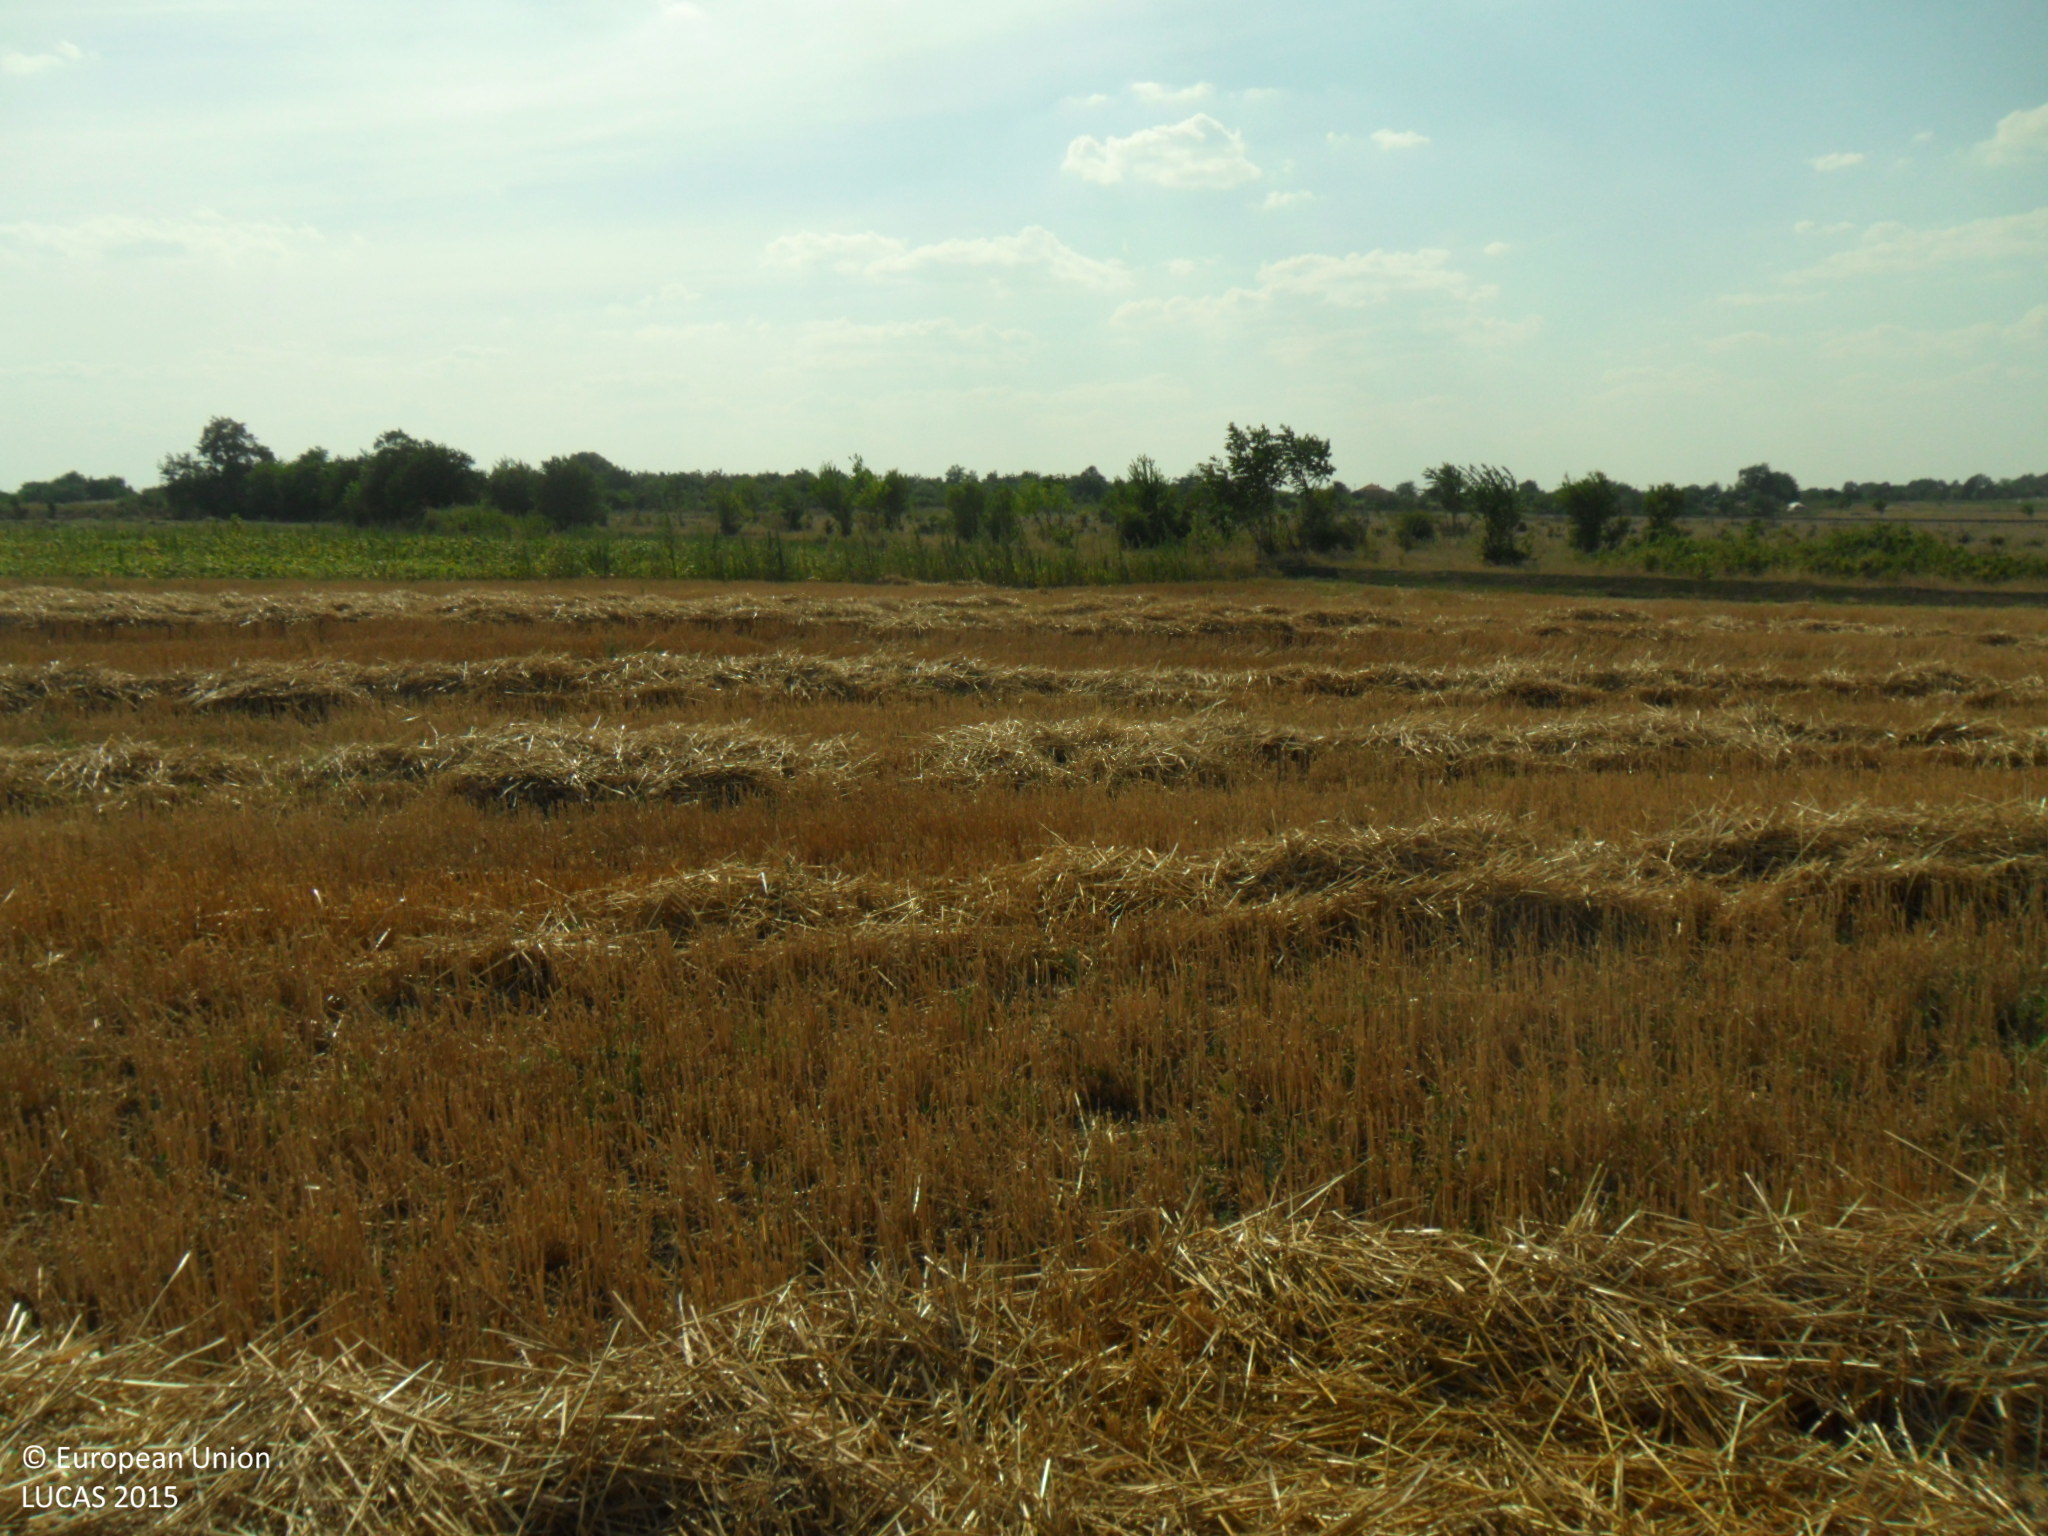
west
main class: Cropland
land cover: Common wheat
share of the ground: 25 - 50 %
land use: Agriculture (excluding fallow land and kitchen gardens)
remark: Harvested field
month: August
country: BG
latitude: 43.6428
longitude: 27.1692
